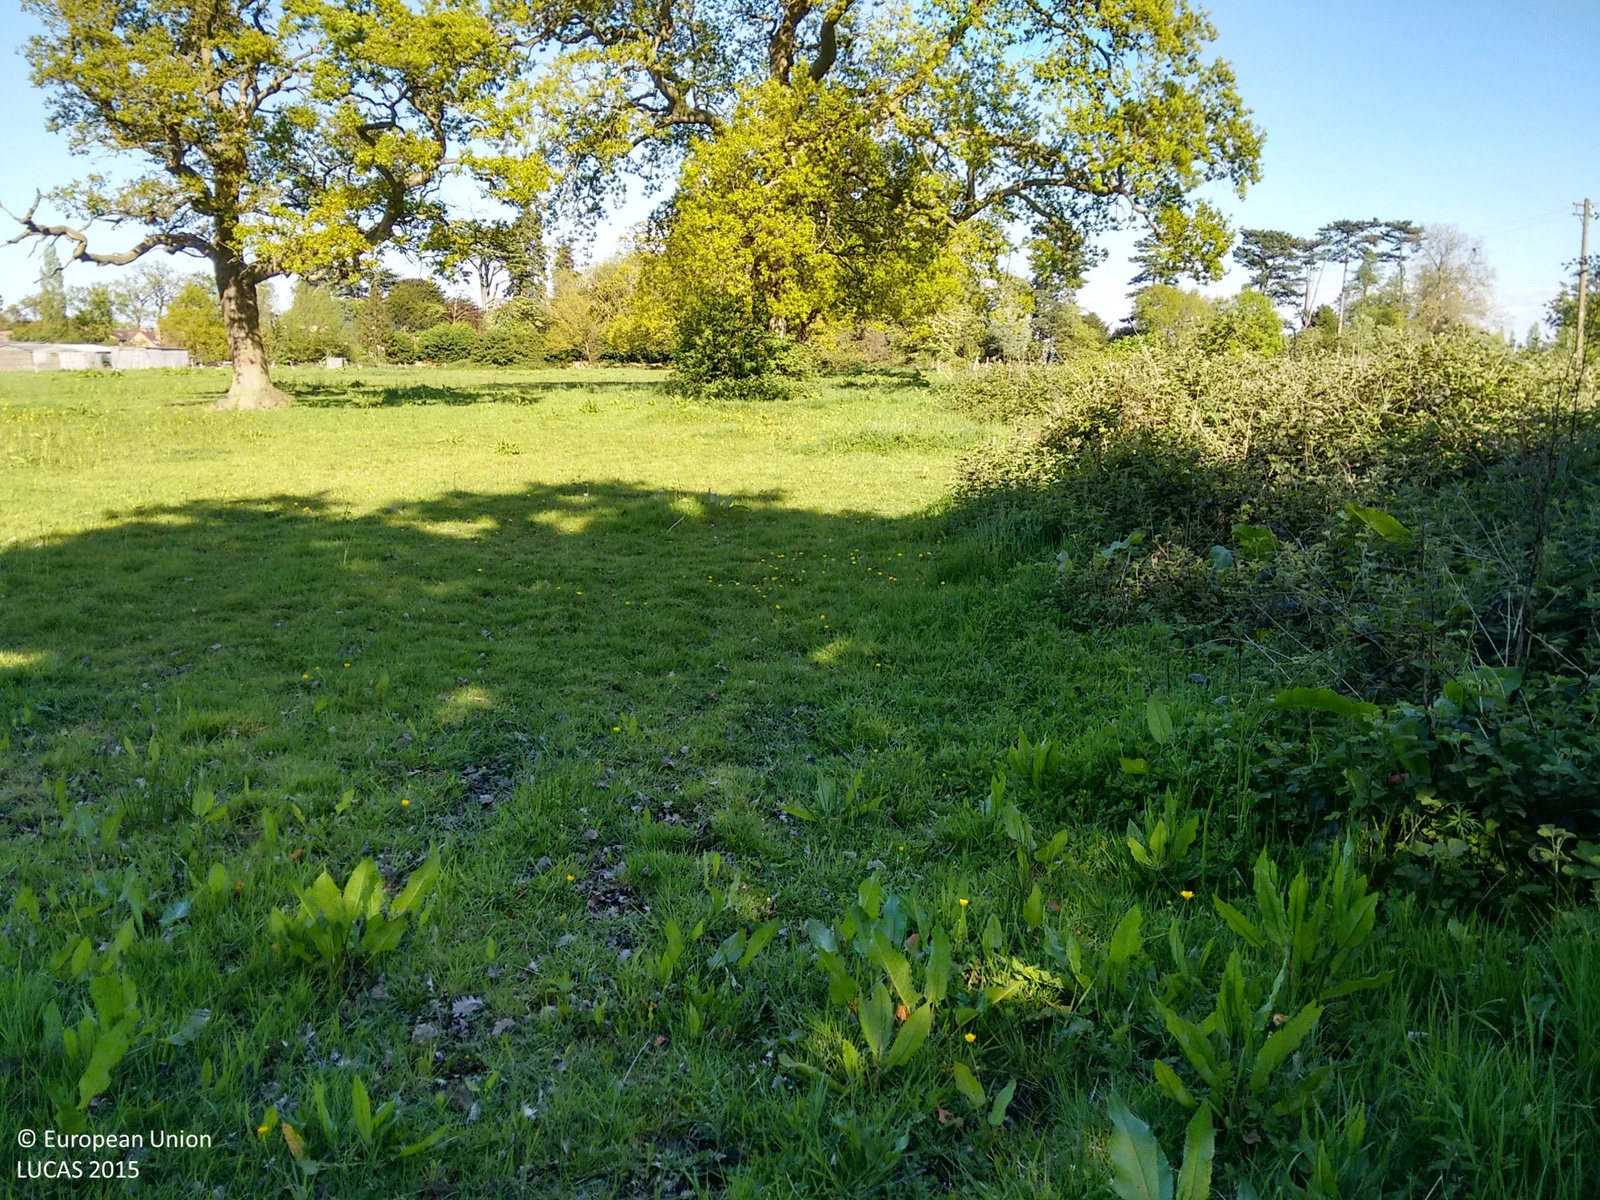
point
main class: Grassland
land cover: Grassland without tree/shrub cover
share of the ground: > 75 %
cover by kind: herbaceous plants 100 %
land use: Agriculture (excluding fallow land and kitchen gardens)
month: May
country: GB
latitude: 52.2716
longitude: -1.6748
